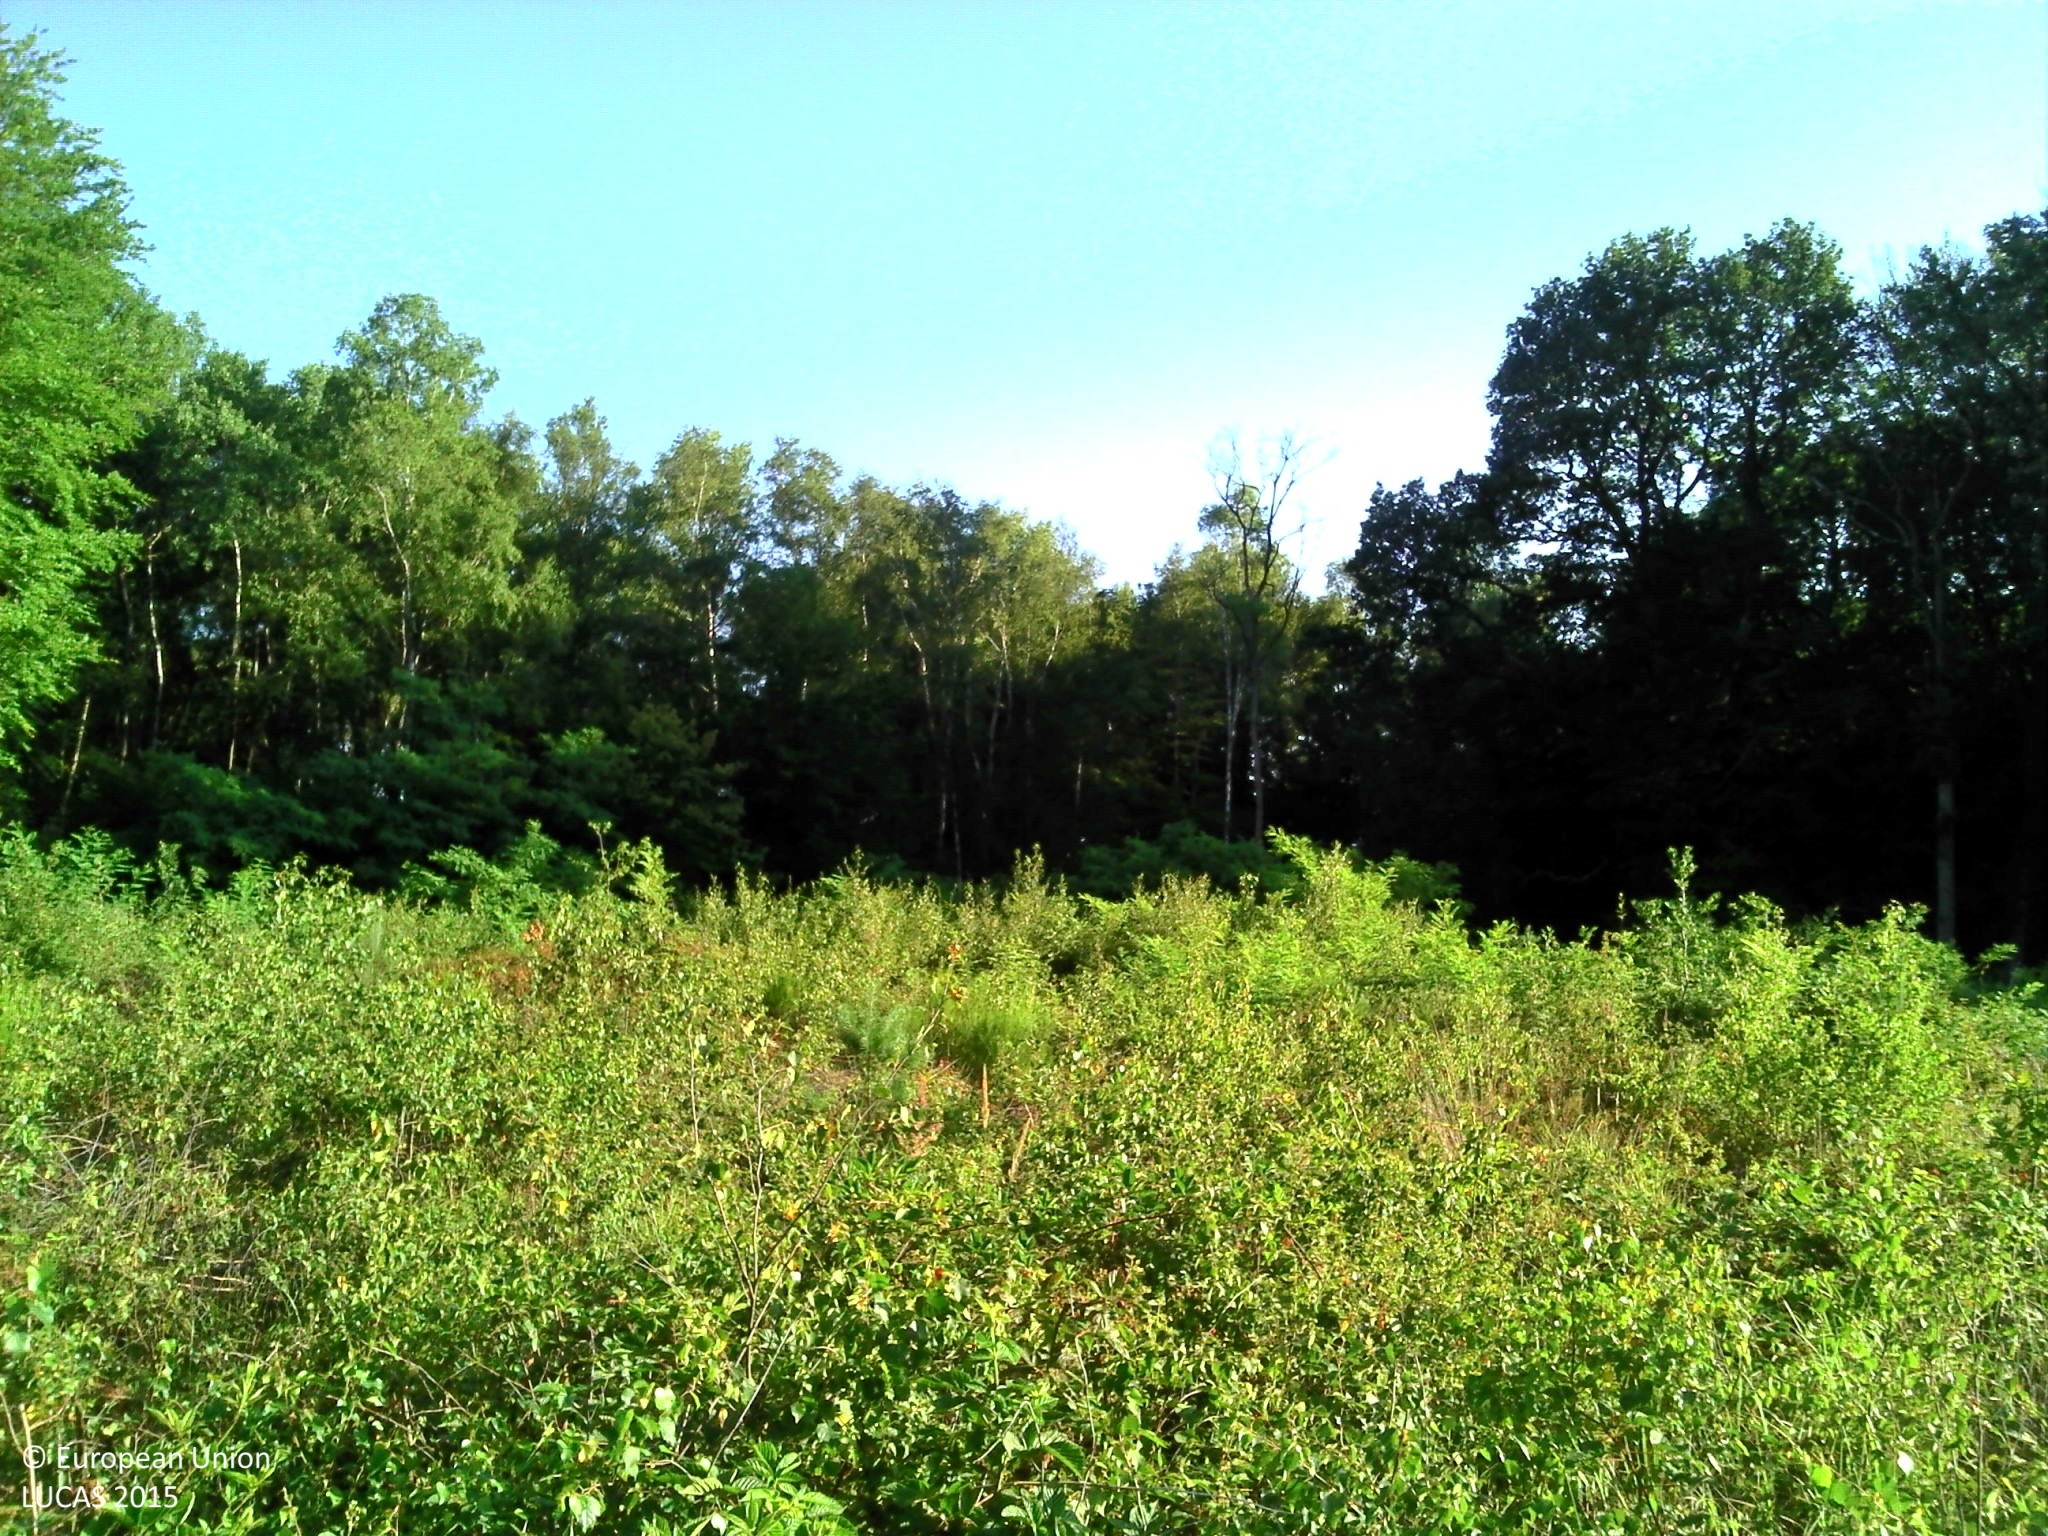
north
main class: Shrubland
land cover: Shrubland without tree cover
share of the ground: > 75 %
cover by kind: shrubs 65 %, herbaceous plants 35 %
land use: Semi-natural and natural areas not in use
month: July
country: FR
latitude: 49.2741
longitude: 2.5803
